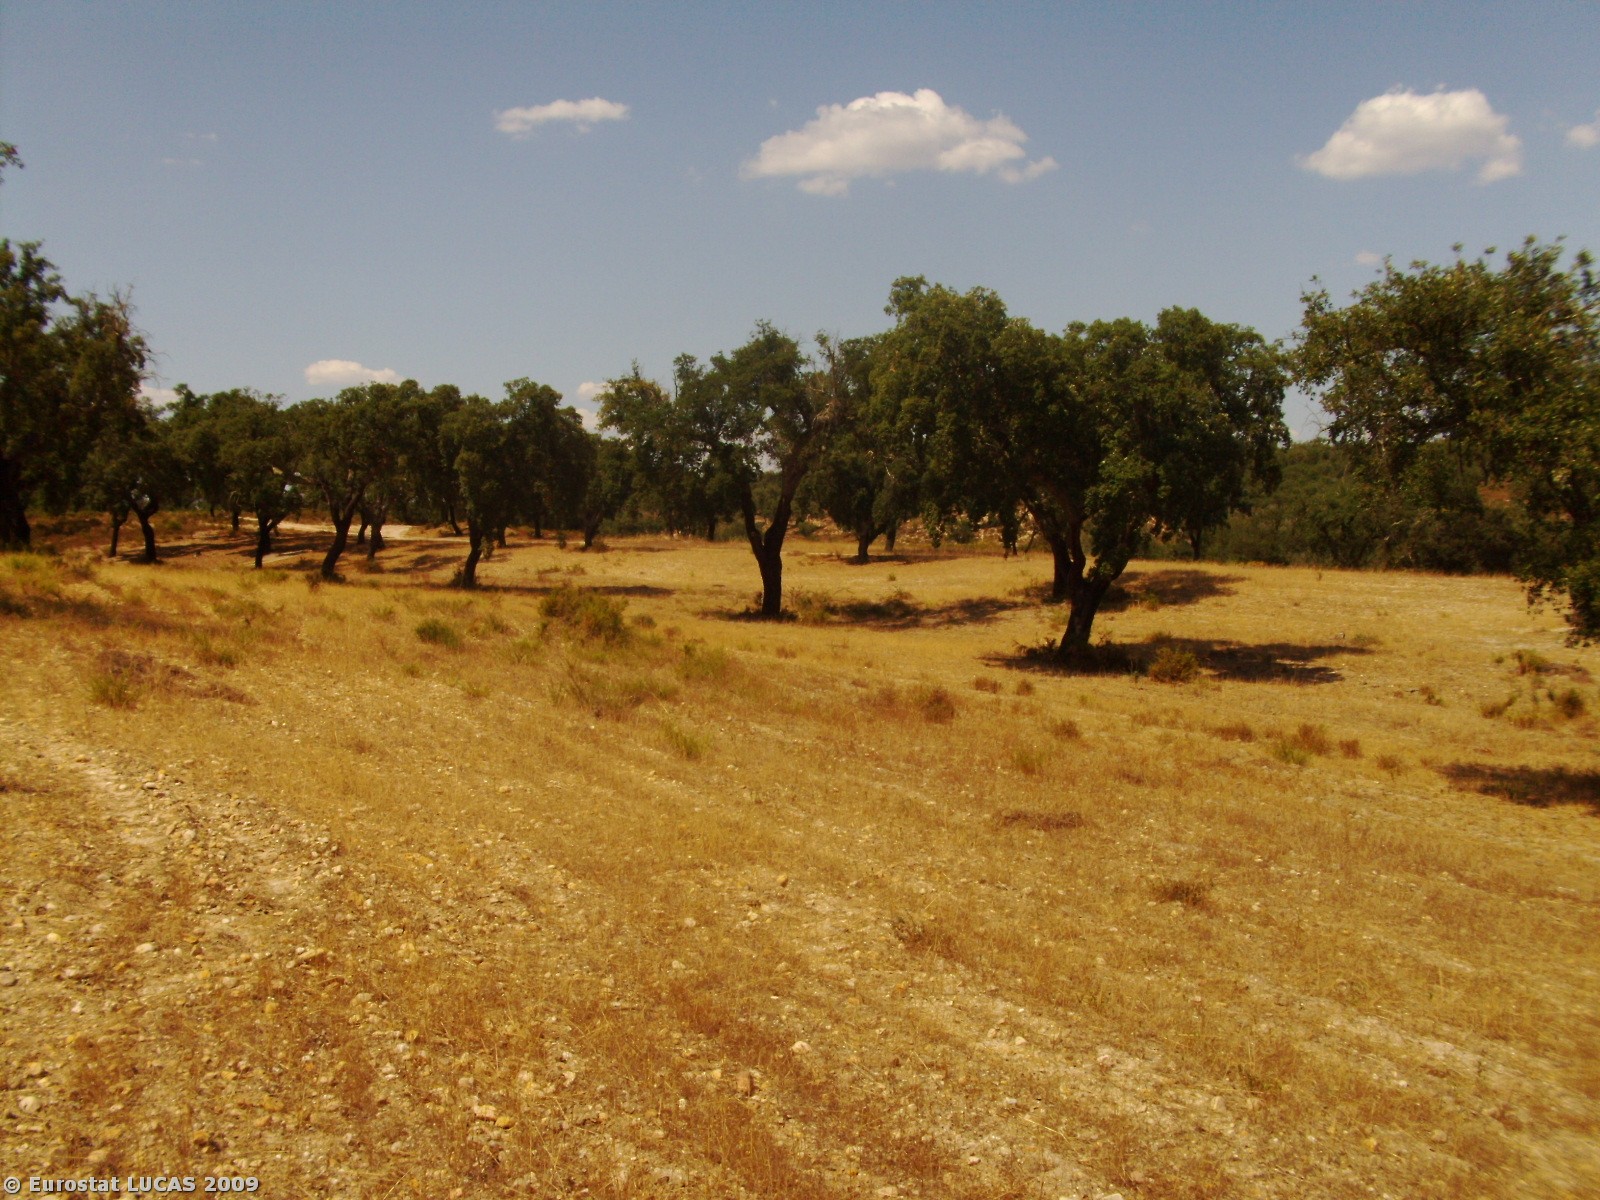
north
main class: Woodland
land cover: Mixed woodland
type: hemiboreal forest and nemoral coniferous forest and mixed broadleaved-coniferous forest
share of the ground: 25 - 50 %
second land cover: Spontaneously vegetated surfaces
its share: 25 - 50 %
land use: Forestry
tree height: > 5 m
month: August
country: PT
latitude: 39.2824
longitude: -8.0367
